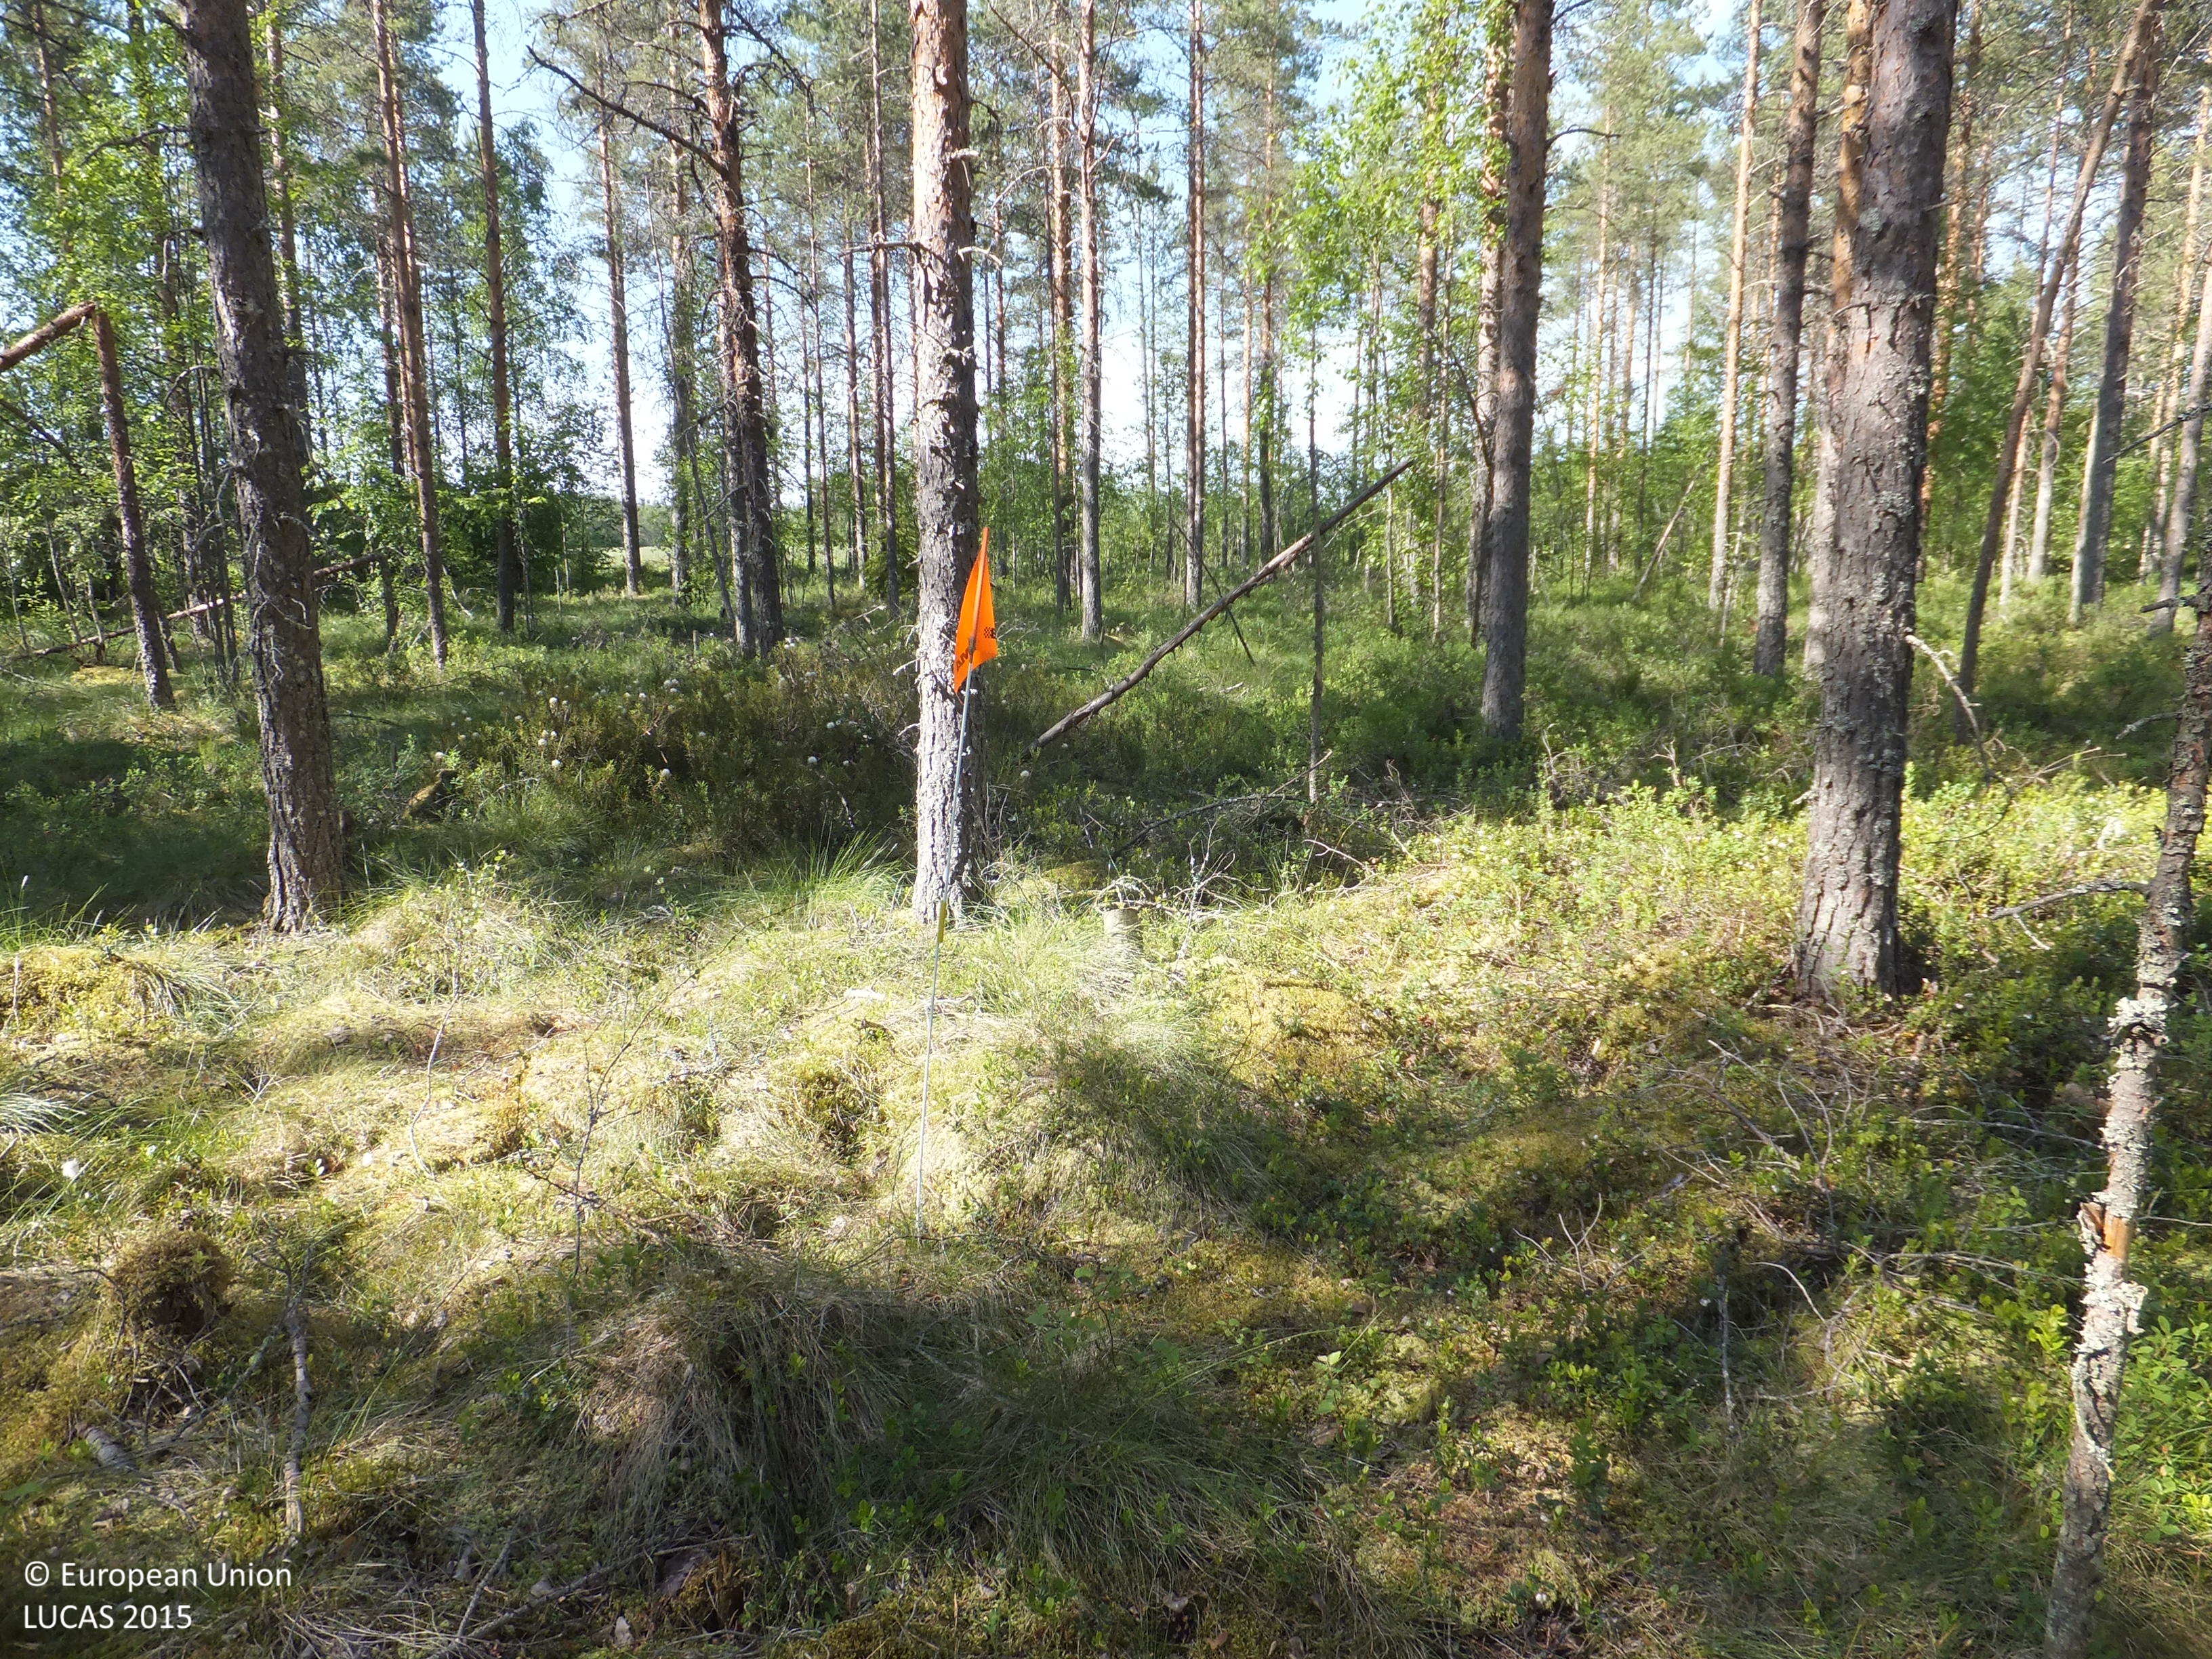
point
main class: Woodland
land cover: Pine dominated mixed woodland
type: boreal forest
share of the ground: 50 - 75 %
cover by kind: coniferous forest trees 45 %, broadleaved forest trees 15 %, shrubs 15 %, lichens and mosses 15 %, herbaceous plants 10 %
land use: Forestry
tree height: > 5 m
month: July
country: FI
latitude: 63.0540
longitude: 24.2218
